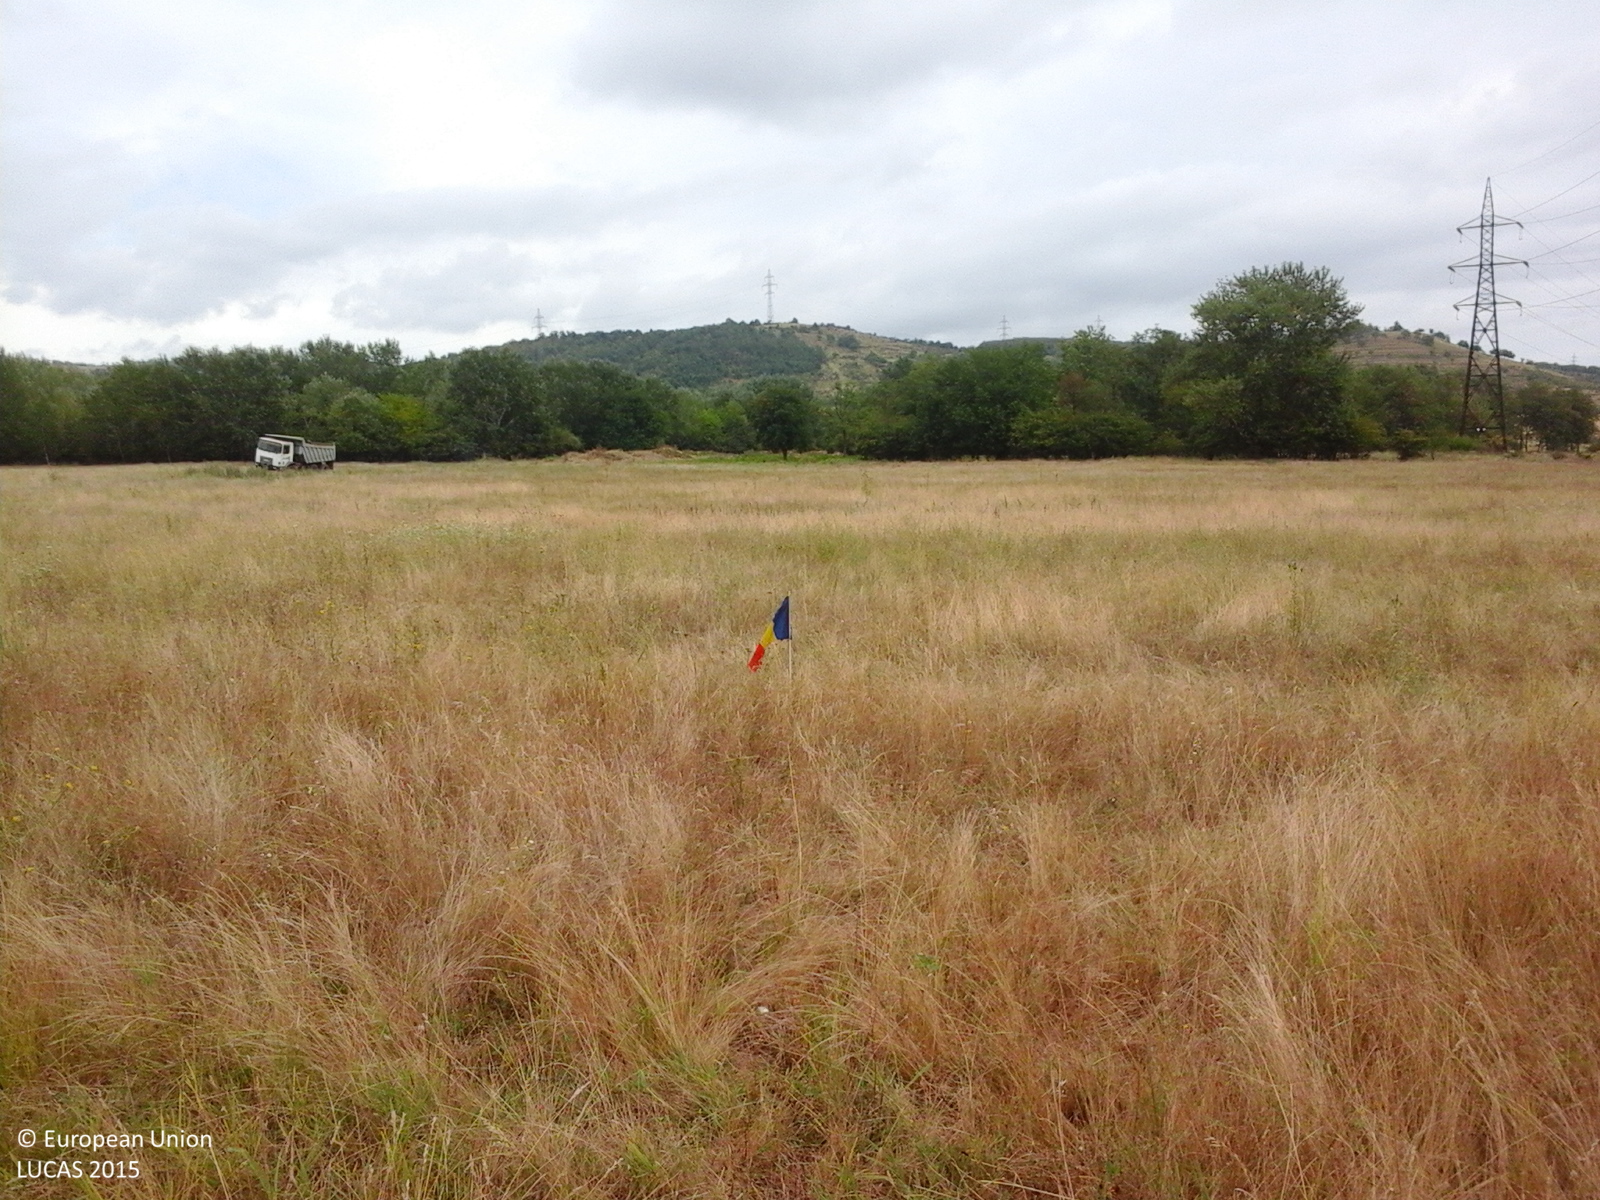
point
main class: Grassland
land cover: Grassland without tree/shrub cover
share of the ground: > 75 %
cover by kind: herbaceous plants 100 %
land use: Agriculture (excluding fallow land and kitchen gardens)
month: August
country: RO
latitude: 44.6204
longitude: 22.7337
